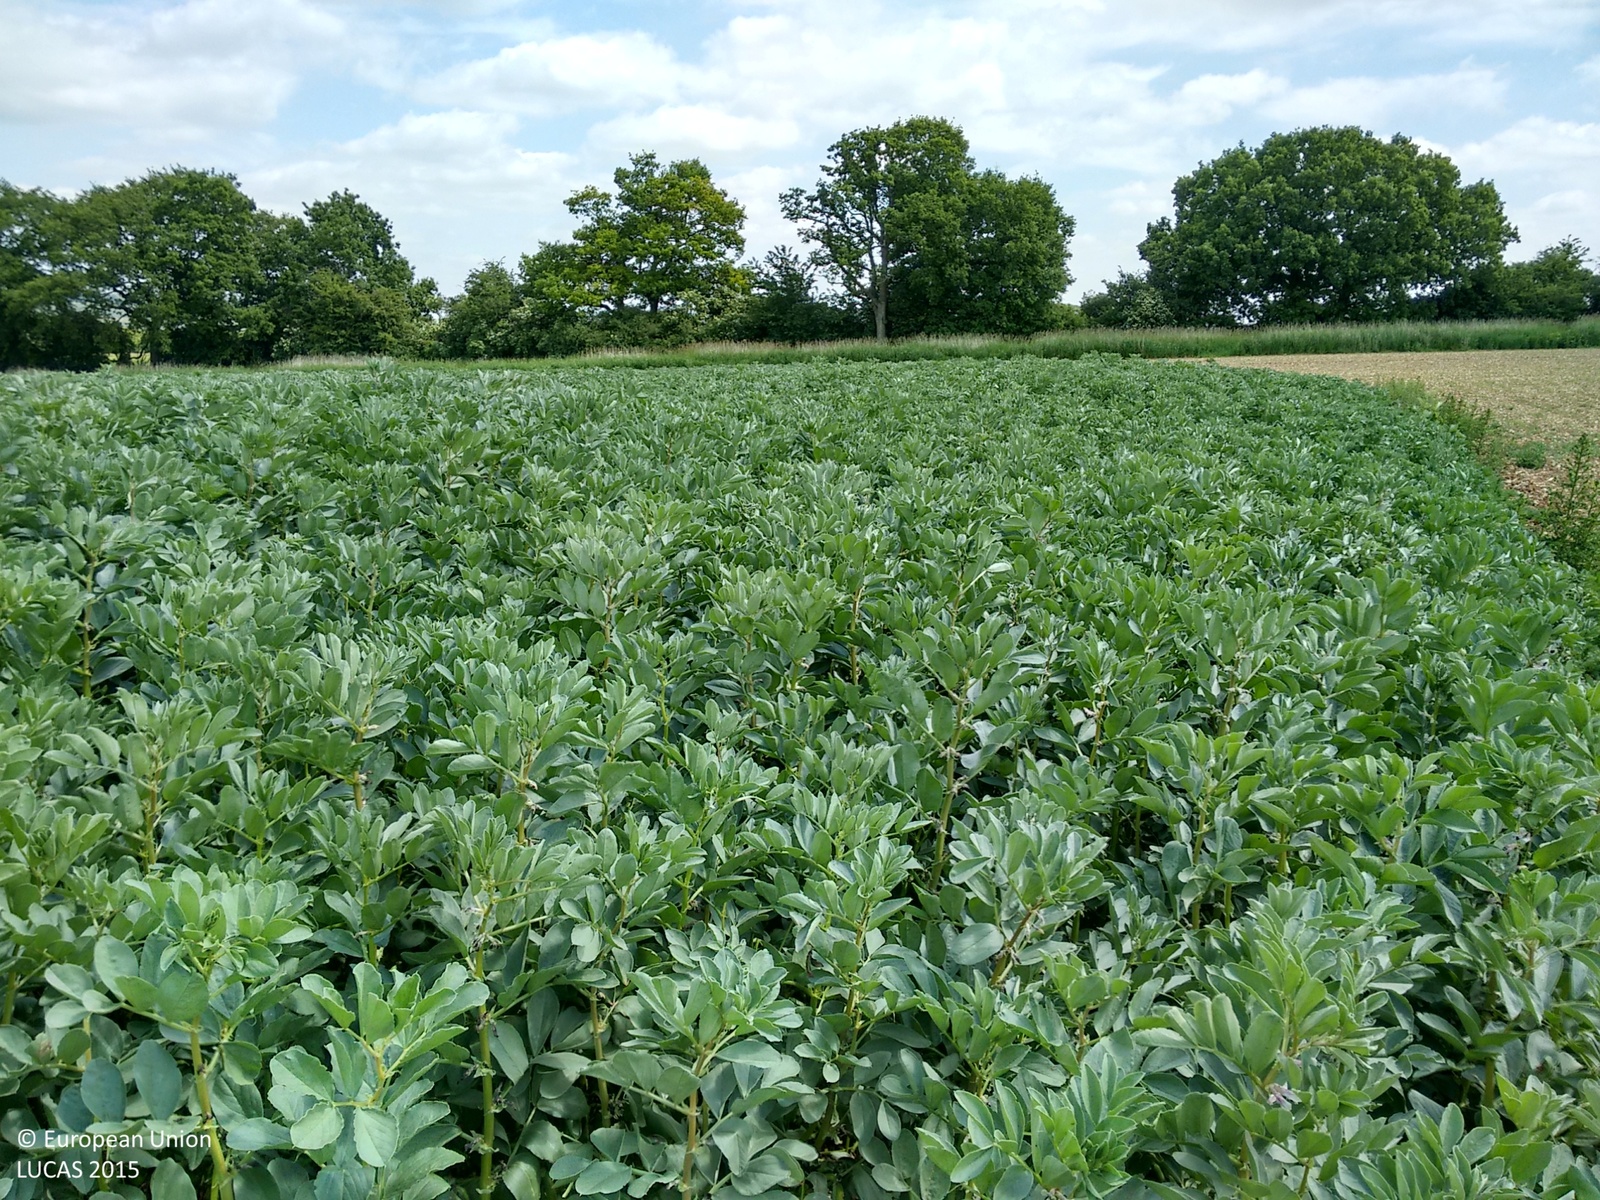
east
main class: Cropland
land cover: Dry pulses
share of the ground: > 75 %
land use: Agriculture (excluding fallow land and kitchen gardens)
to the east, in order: Dry pulses; Maize; Grassland without tree/shrub cover; Broadleaved woodland; Ditches and canals; Fences; Grassland without tree/shrub cover; Common wheat
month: June
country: GB
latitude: 51.4744
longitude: -1.4679
